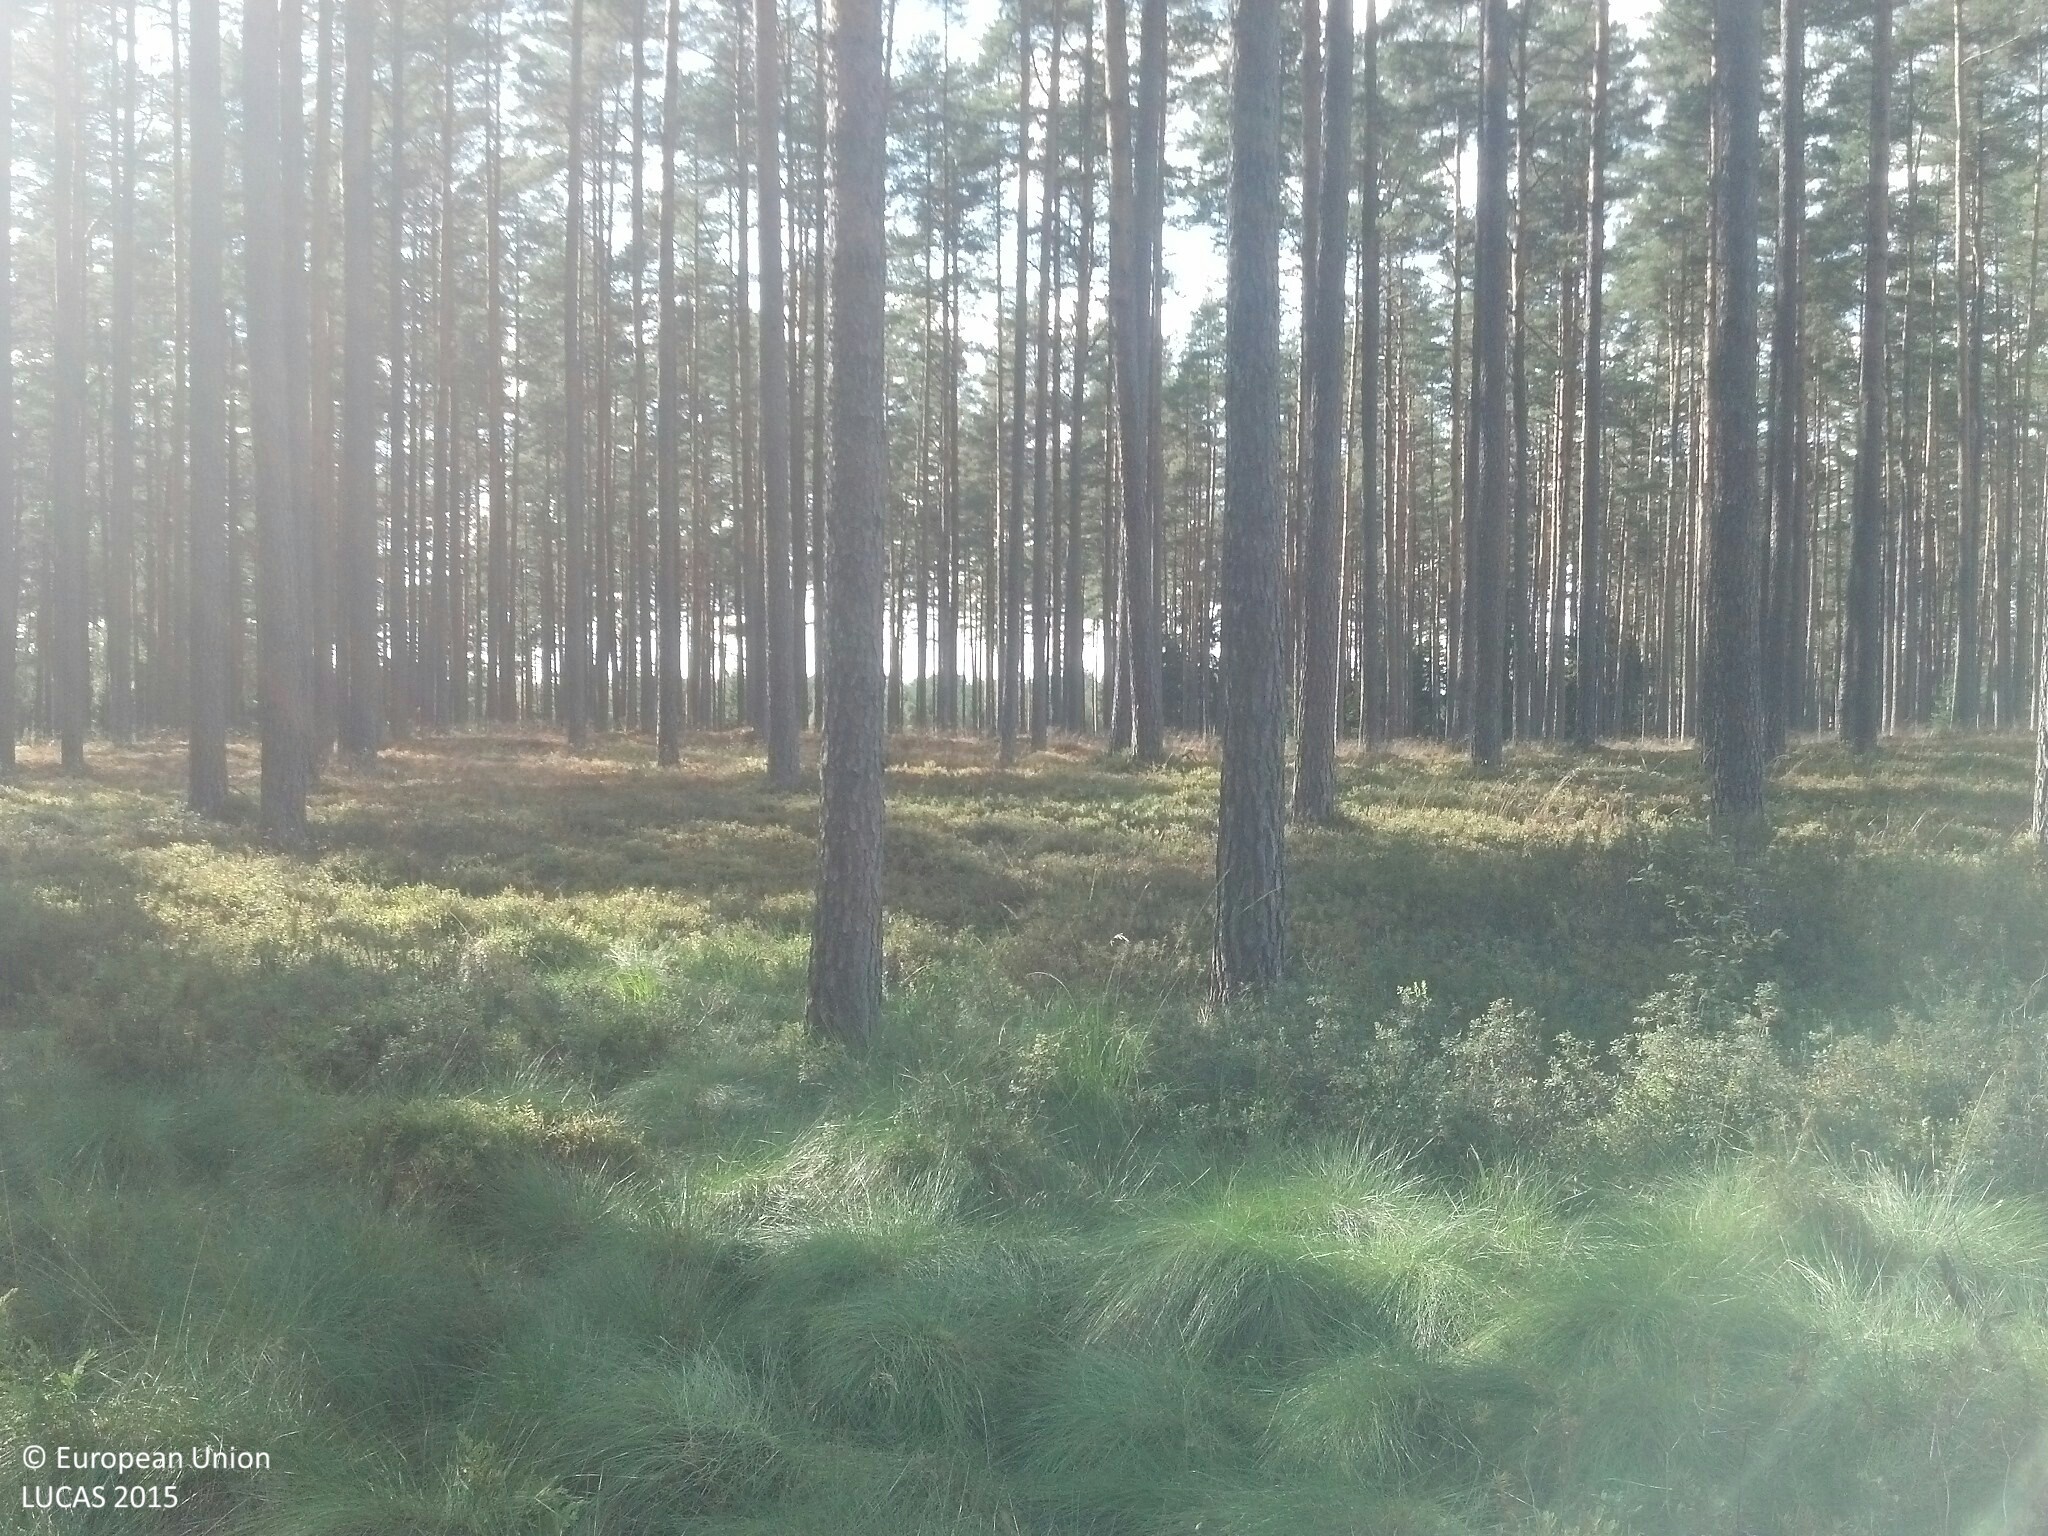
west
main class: Woodland
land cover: Pine dominated coniferous woodland
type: hemiboreal forest and nemoral coniferous forest and mixed broadleaved-coniferous forest
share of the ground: > 75 %
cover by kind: coniferous forest trees 85 %, herbaceous plants 10 %, shrubs 5 %
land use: Forestry
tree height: > 5 m
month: August
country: PL
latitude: 53.9286
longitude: 17.1827
